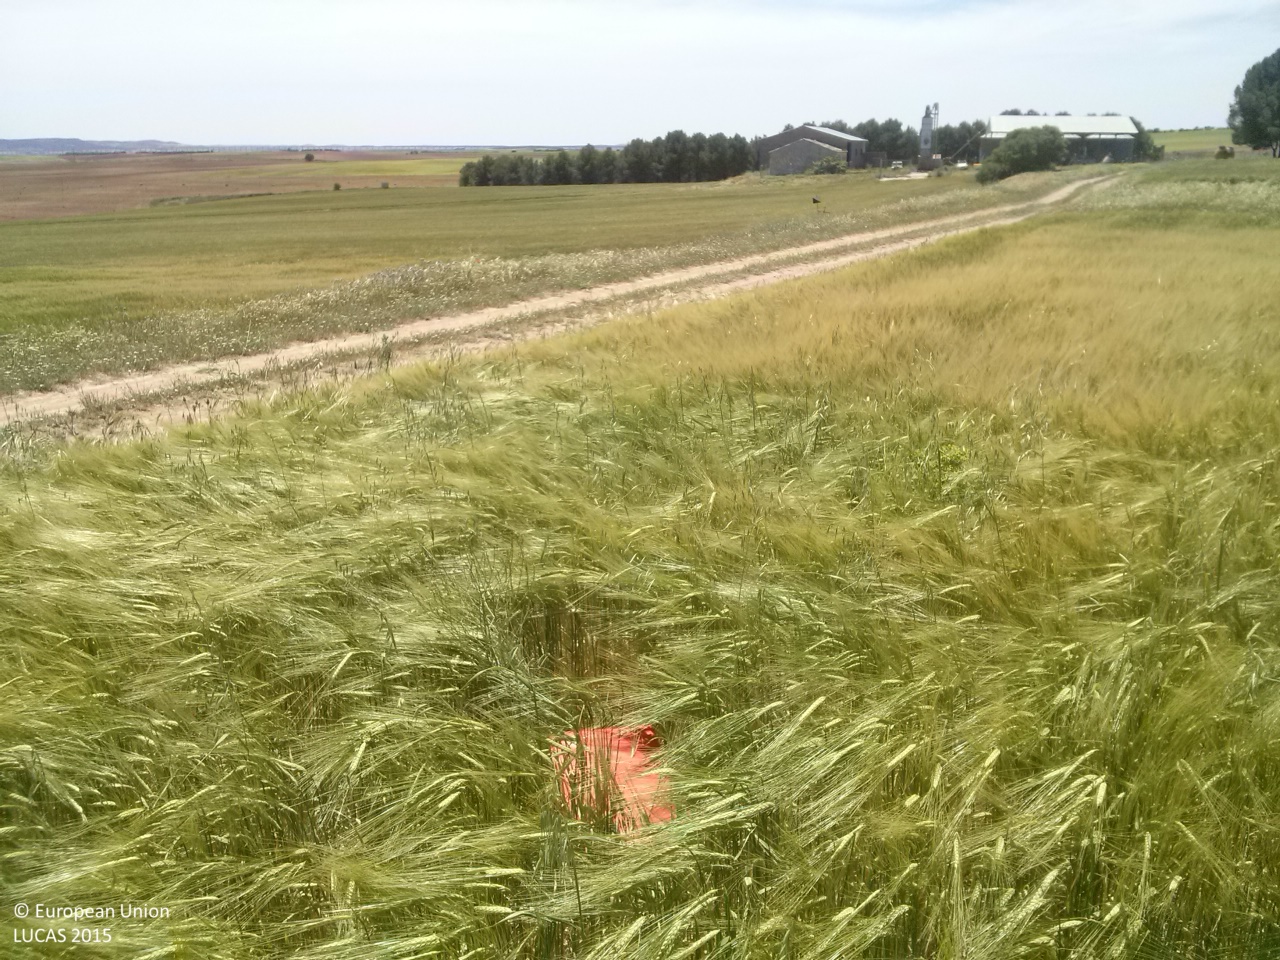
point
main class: Cropland
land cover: Barley
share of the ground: > 75 %
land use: Agriculture (excluding fallow land and kitchen gardens)
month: May
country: ES
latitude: 40.0075
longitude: -2.6837
